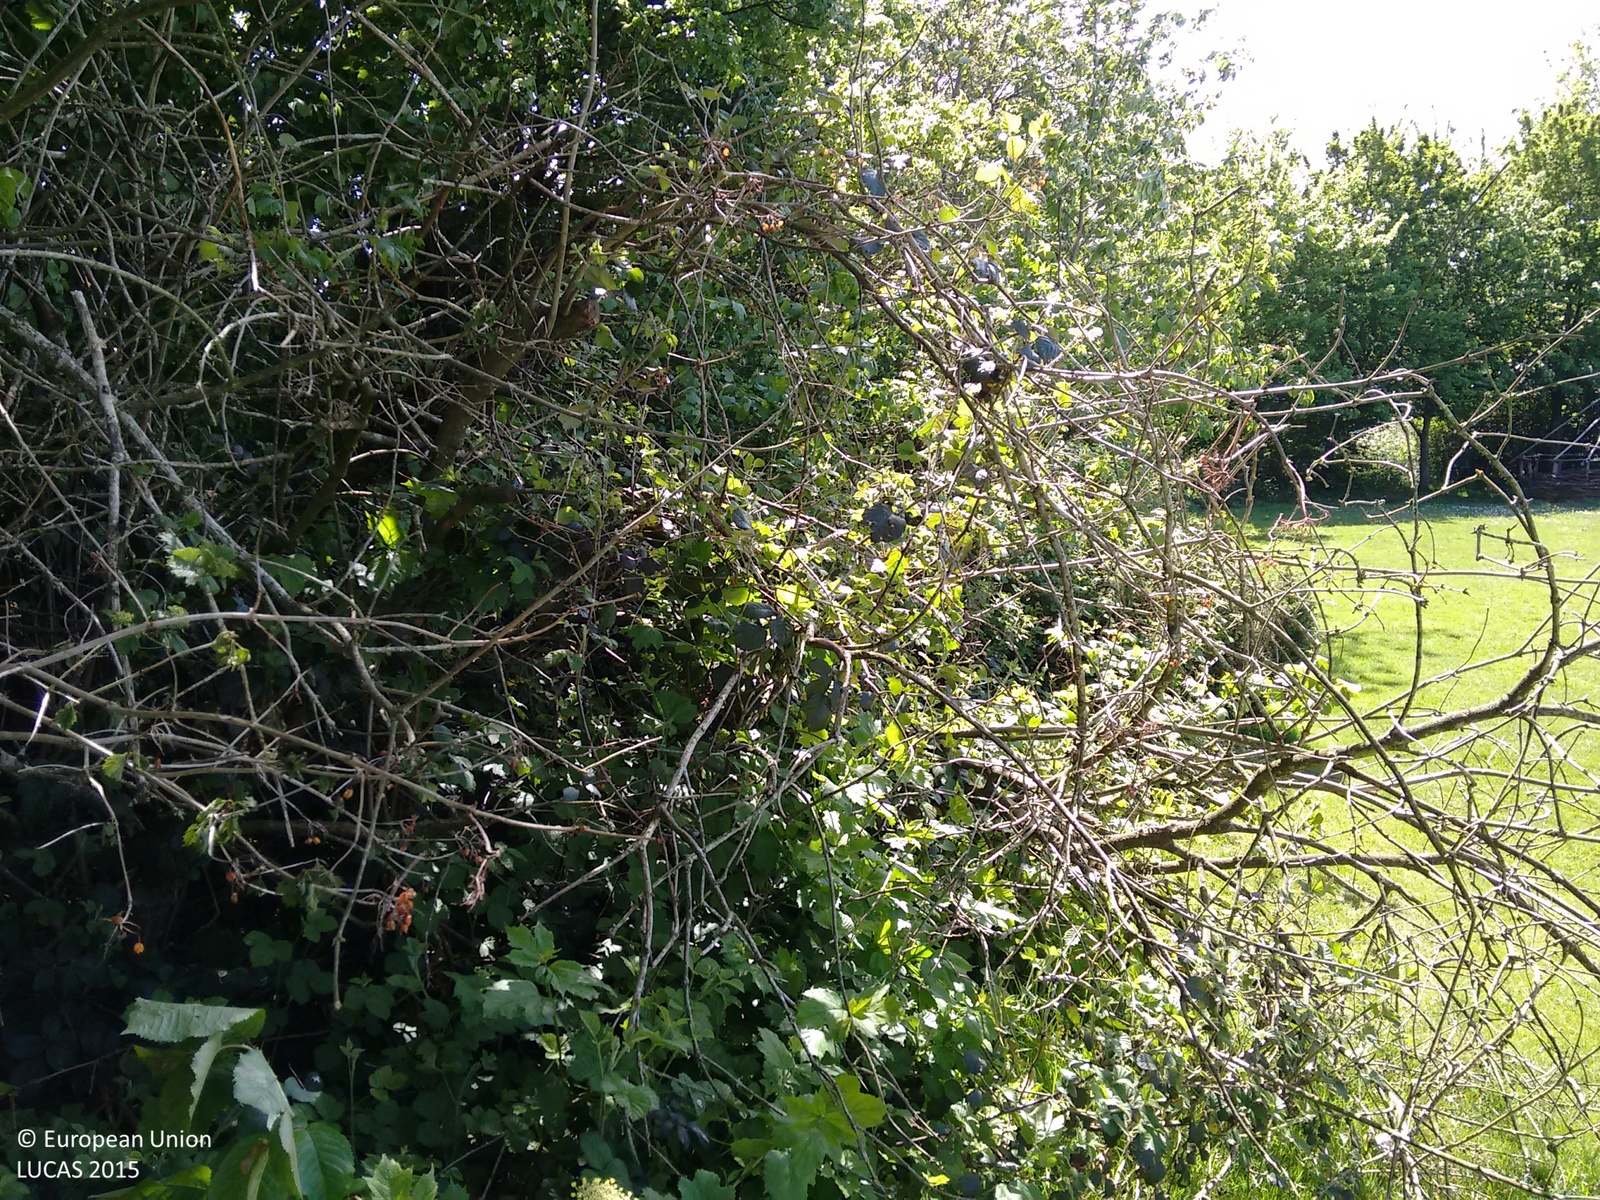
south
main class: Woodland
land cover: Broadleaved woodland
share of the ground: > 75 %
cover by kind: broadleaved forest trees 85 %, shrubs 15 %
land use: Residential
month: May
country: GB
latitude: 51.3549
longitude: -1.2047
